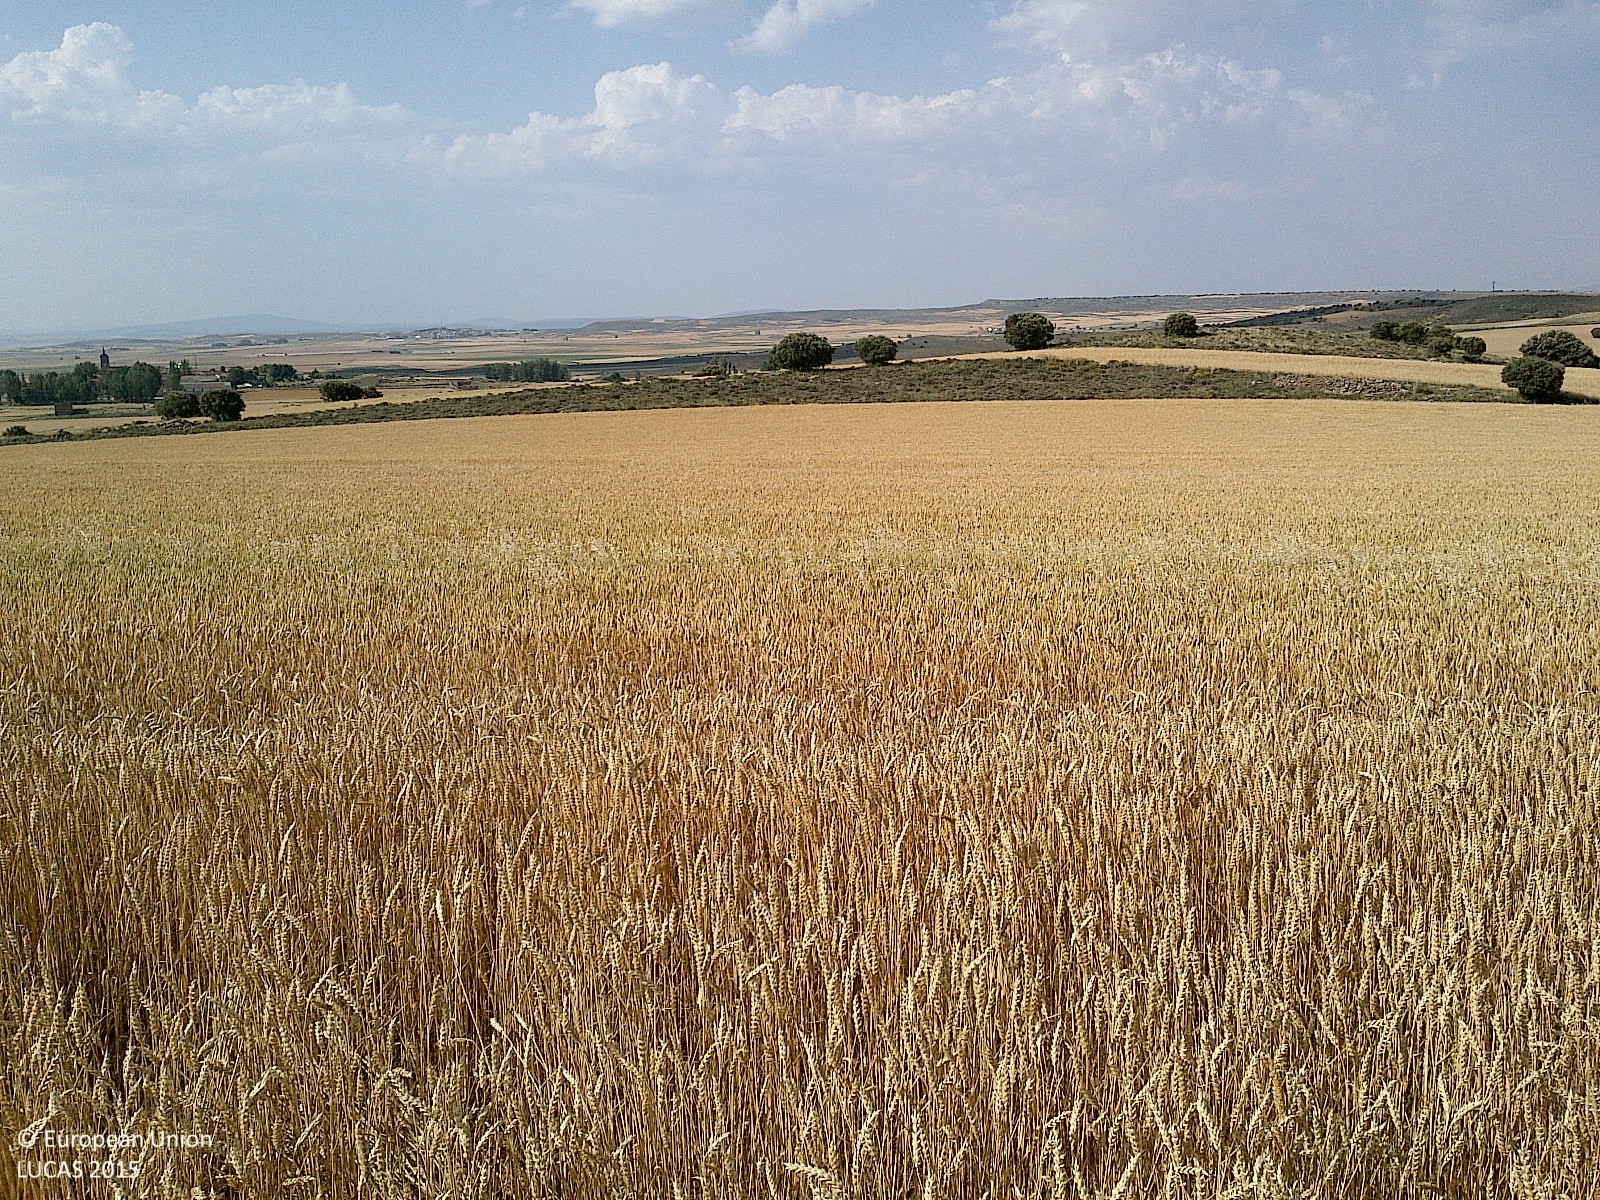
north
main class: Cropland
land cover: Common wheat
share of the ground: > 75 %
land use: Agriculture (excluding fallow land and kitchen gardens)
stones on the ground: < 10 %
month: June
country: ES
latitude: 41.5634
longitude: -2.2282
